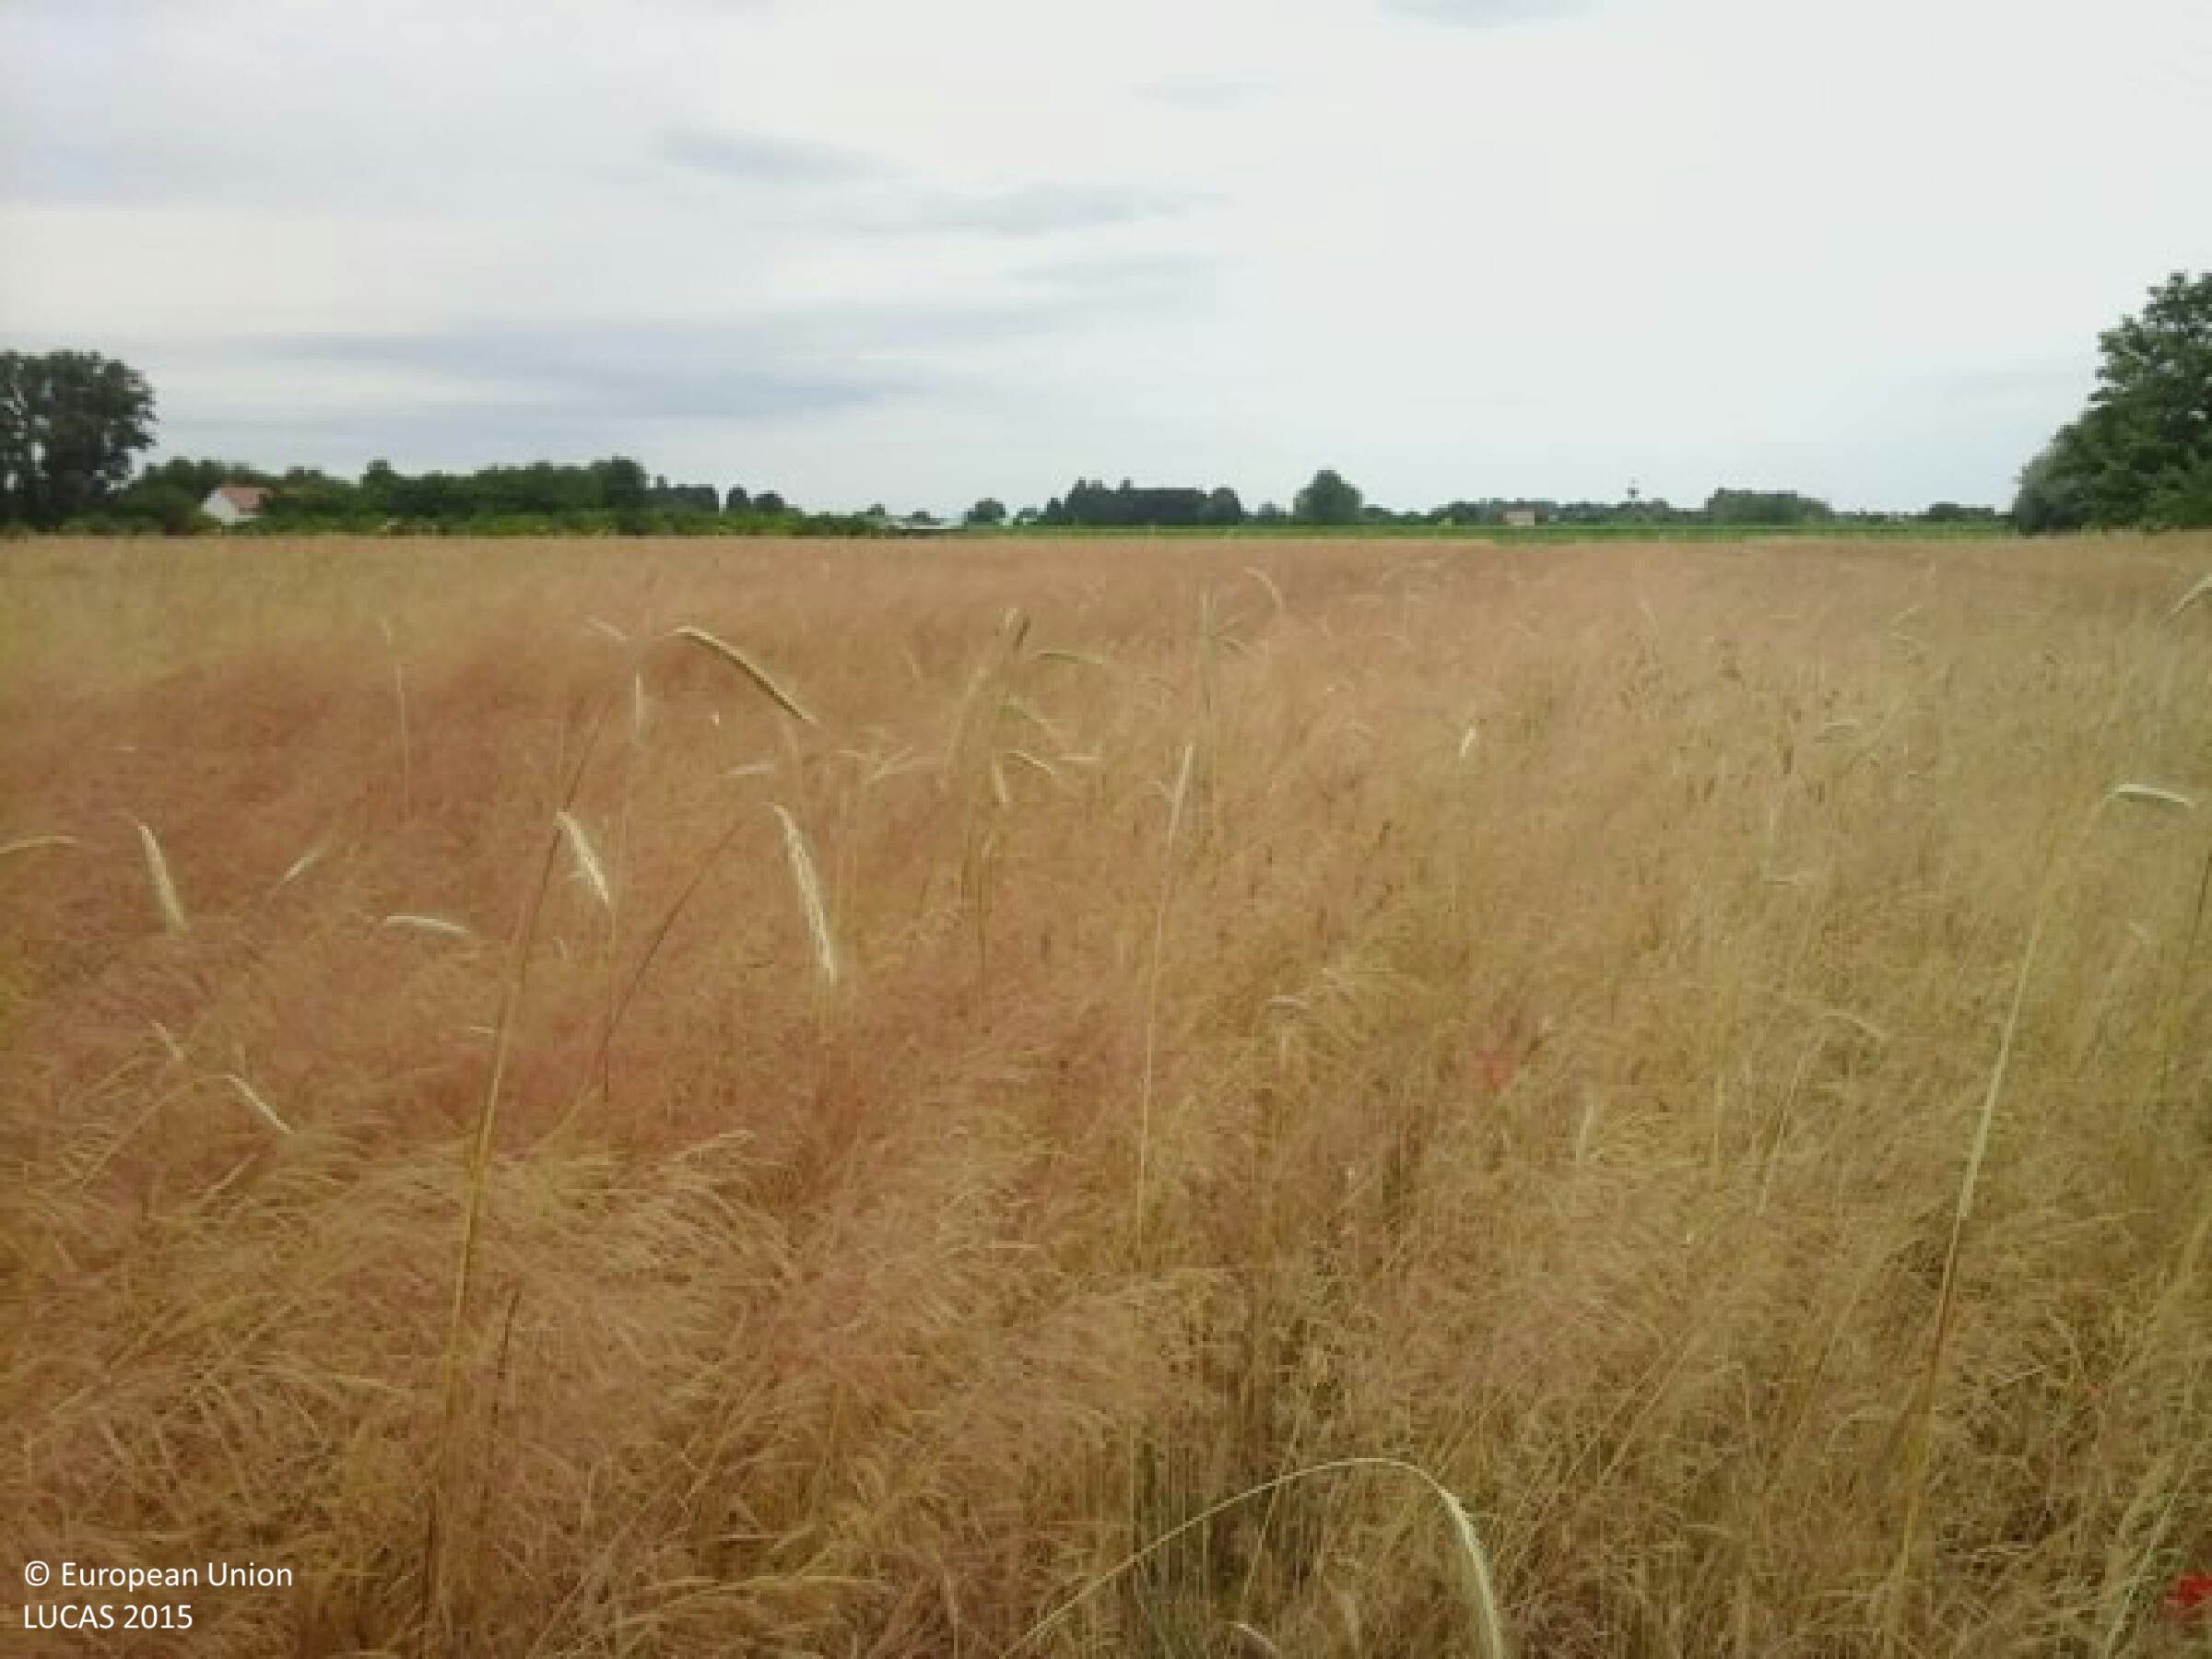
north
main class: Grassland
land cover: Grassland without tree/shrub cover
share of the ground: > 75 %
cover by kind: herbaceous plants 100 %
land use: Agriculture (excluding fallow land and kitchen gardens)
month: June
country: HU
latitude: 46.7535
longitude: 19.5889
